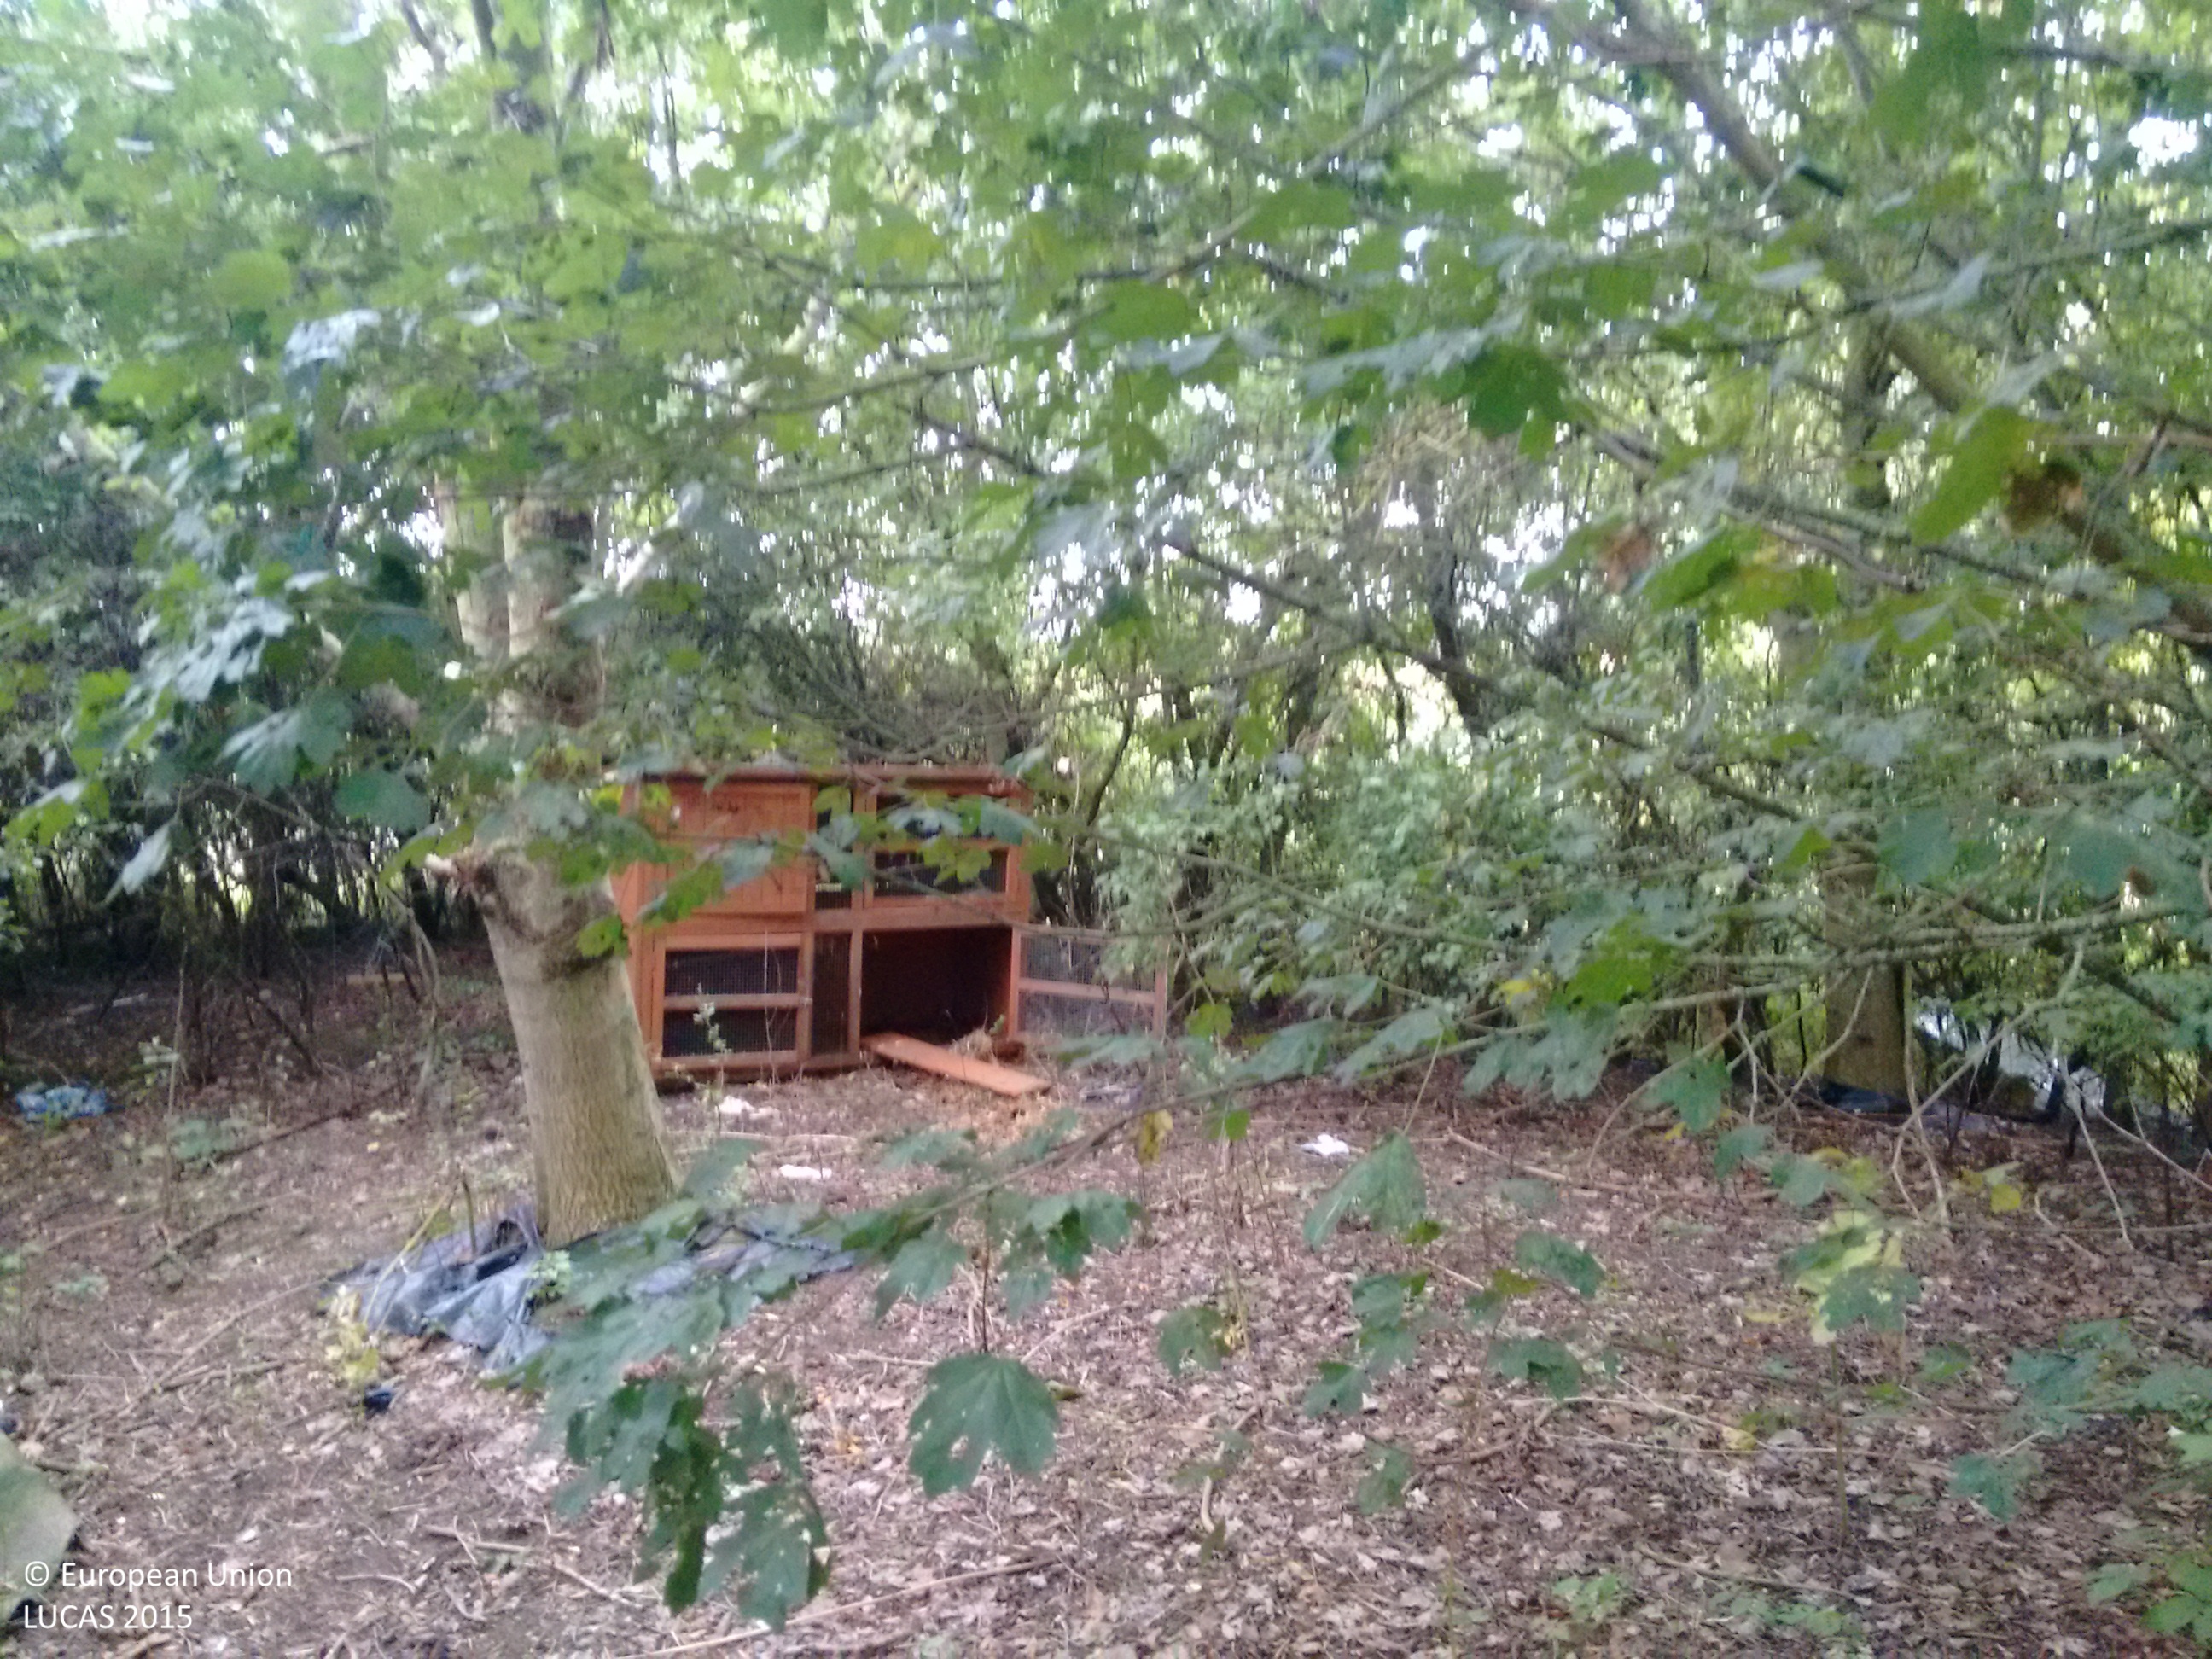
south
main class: Woodland
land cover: Broadleaved woodland
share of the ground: > 75 %
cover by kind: broadleaved forest trees 75 %, shrubs 25 %
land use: Semi-natural and natural areas not in use
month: September
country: GB
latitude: 52.2679
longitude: 0.2842
